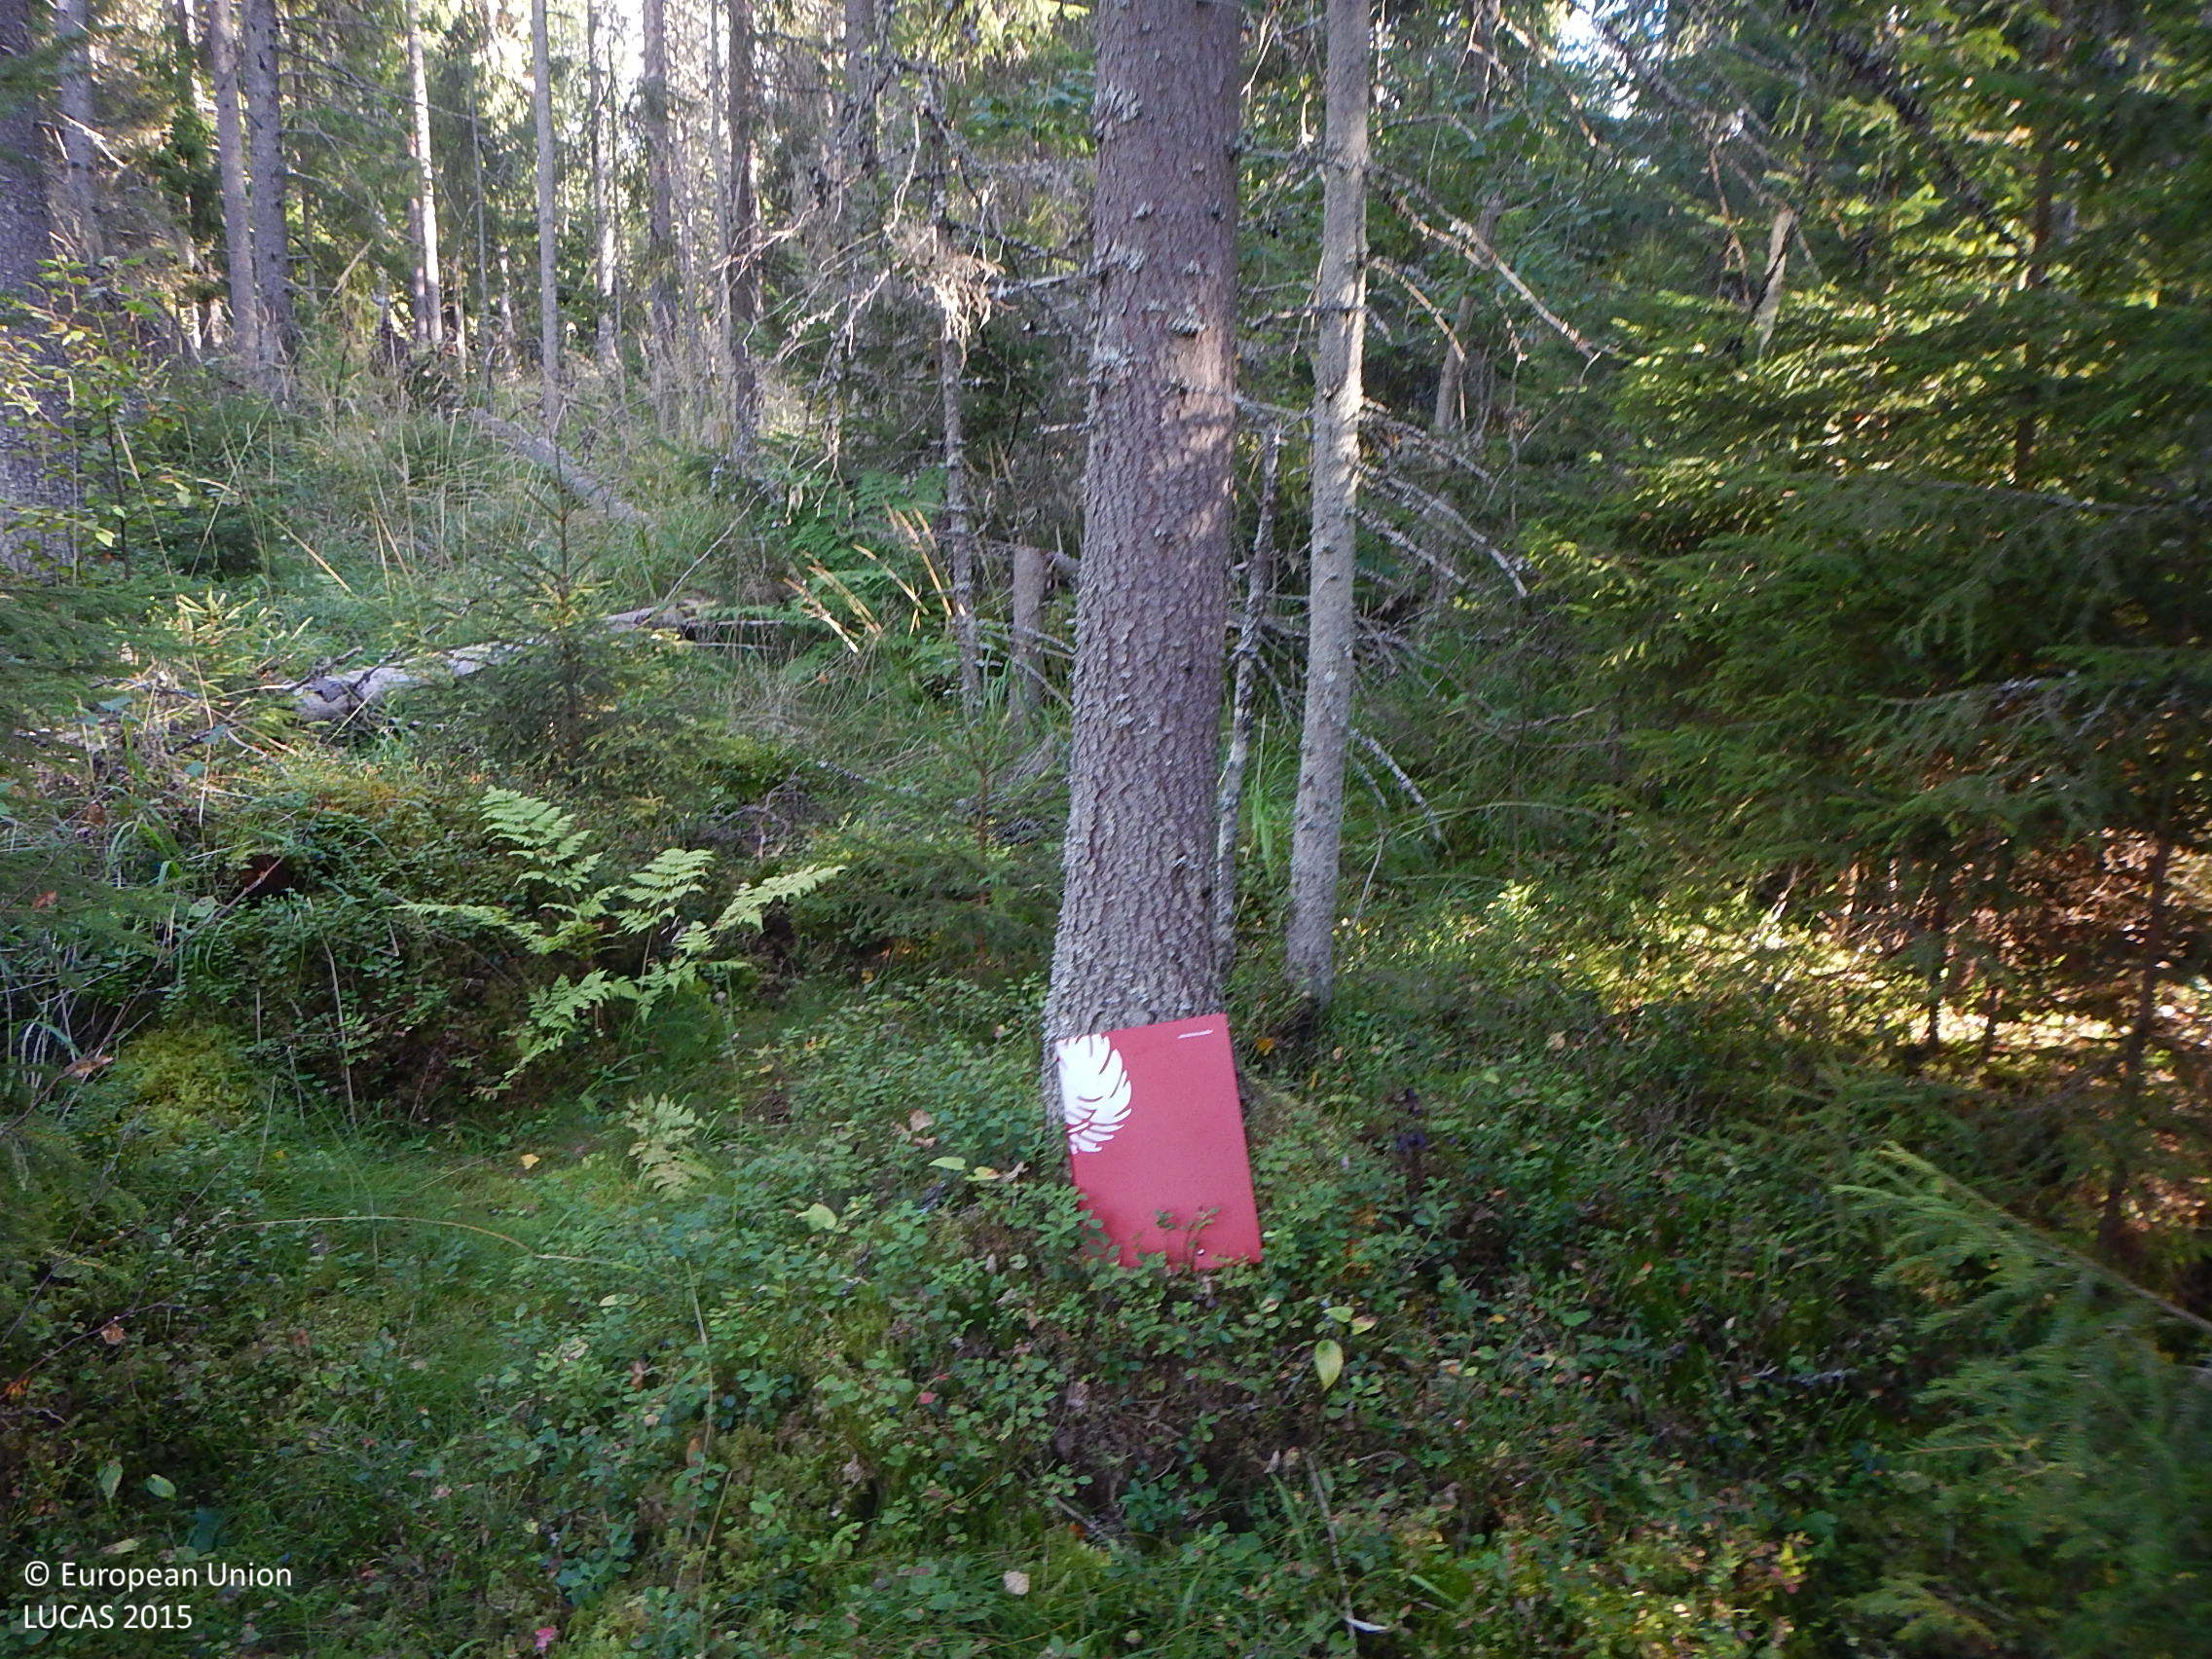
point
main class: Woodland
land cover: Spruce dominated coniferous woodland
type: boreal forest
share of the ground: > 75 %
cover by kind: coniferous forest trees 70 %, shrubs 20 %, broadleaved forest trees 10 %
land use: Forestry
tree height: > 5 m
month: September
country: FI
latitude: 61.4865
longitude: 22.0569
